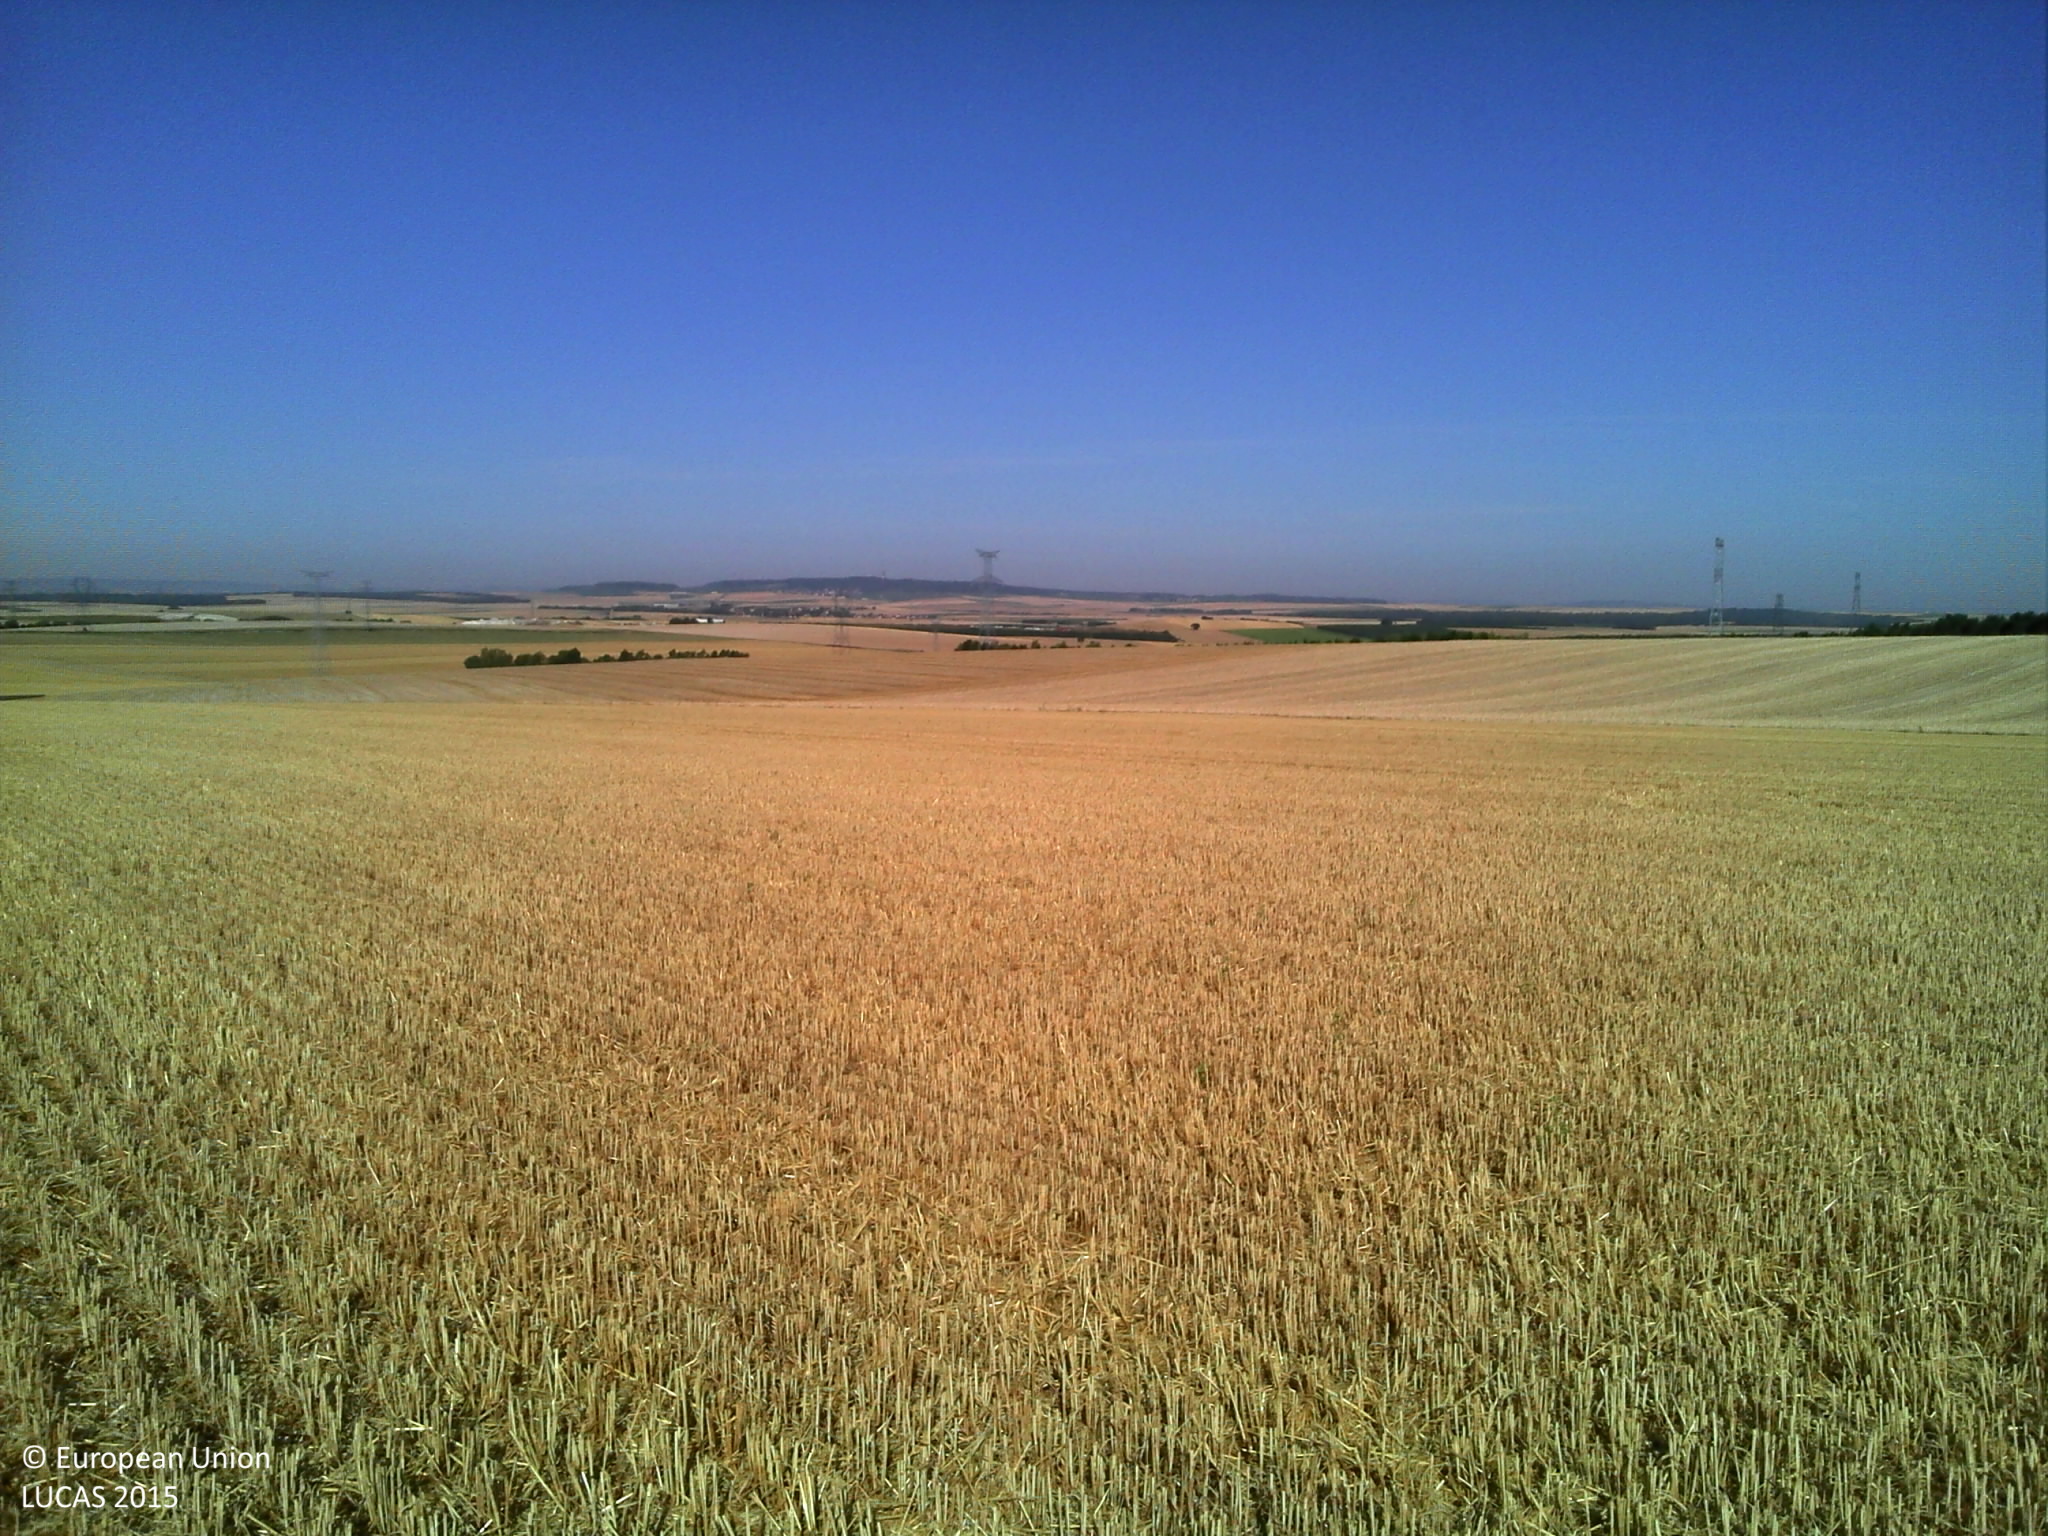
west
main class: Cropland
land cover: Common wheat
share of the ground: > 75 %
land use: Agriculture (excluding fallow land and kitchen gardens)
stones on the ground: < 10 %
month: August
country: FR
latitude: 49.2481
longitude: 4.2948
